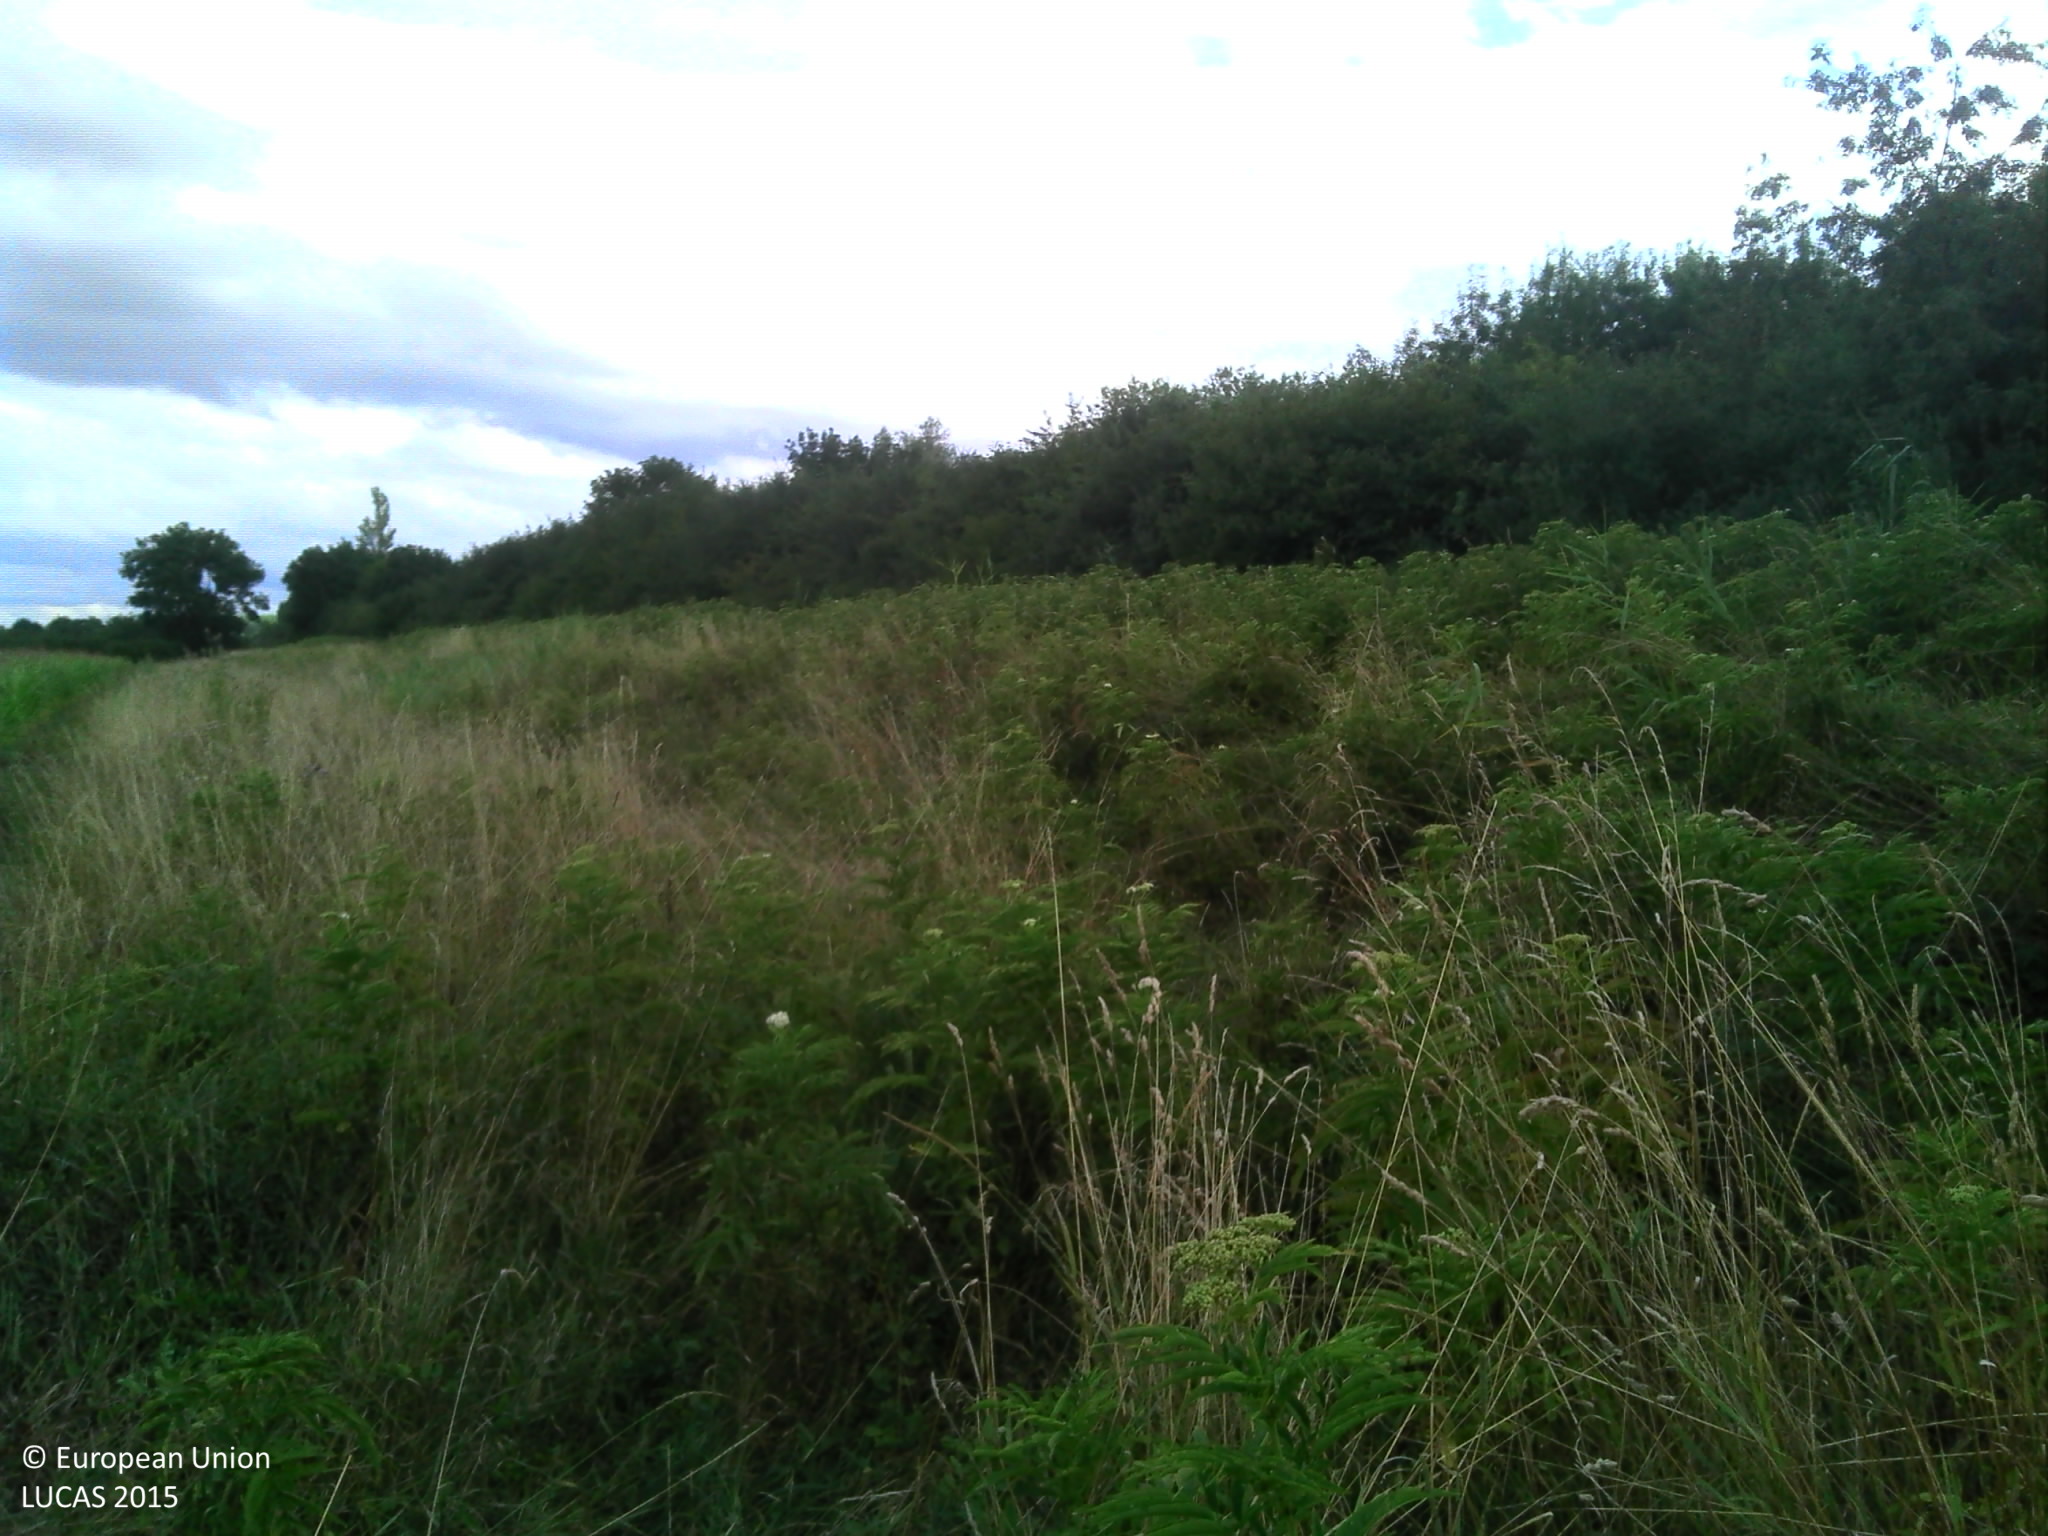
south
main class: Grassland
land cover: Spontaneously vegetated surfaces
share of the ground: > 75 %
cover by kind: herbaceous plants 100 %
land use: Agriculture (excluding fallow land and kitchen gardens)
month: July
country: FR
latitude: 46.7006
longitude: 4.9403
